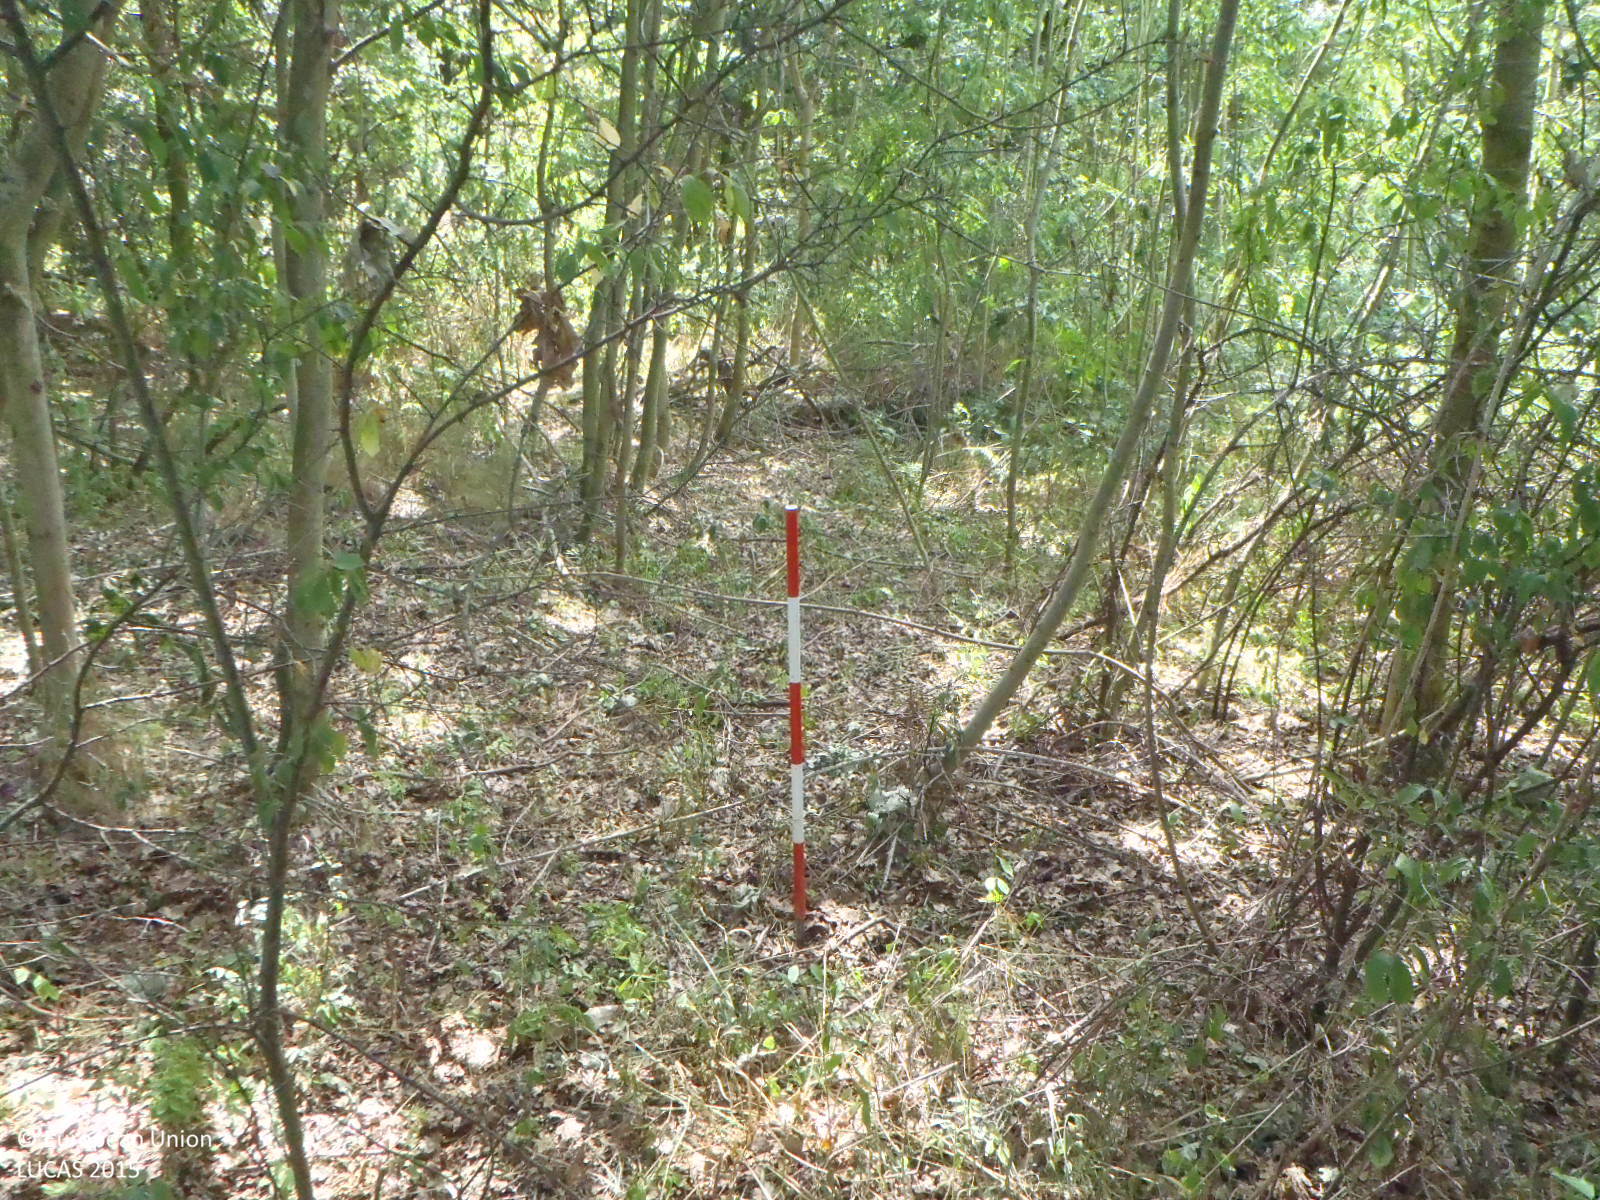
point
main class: Woodland
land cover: Broadleaved woodland
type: mesophytic deciduous forest
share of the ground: > 75 %
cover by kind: broadleaved forest trees 95 %, shrubs 5 %
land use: Forestry
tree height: > 5 m
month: July
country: CZ
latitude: 49.0337
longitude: 14.4739
